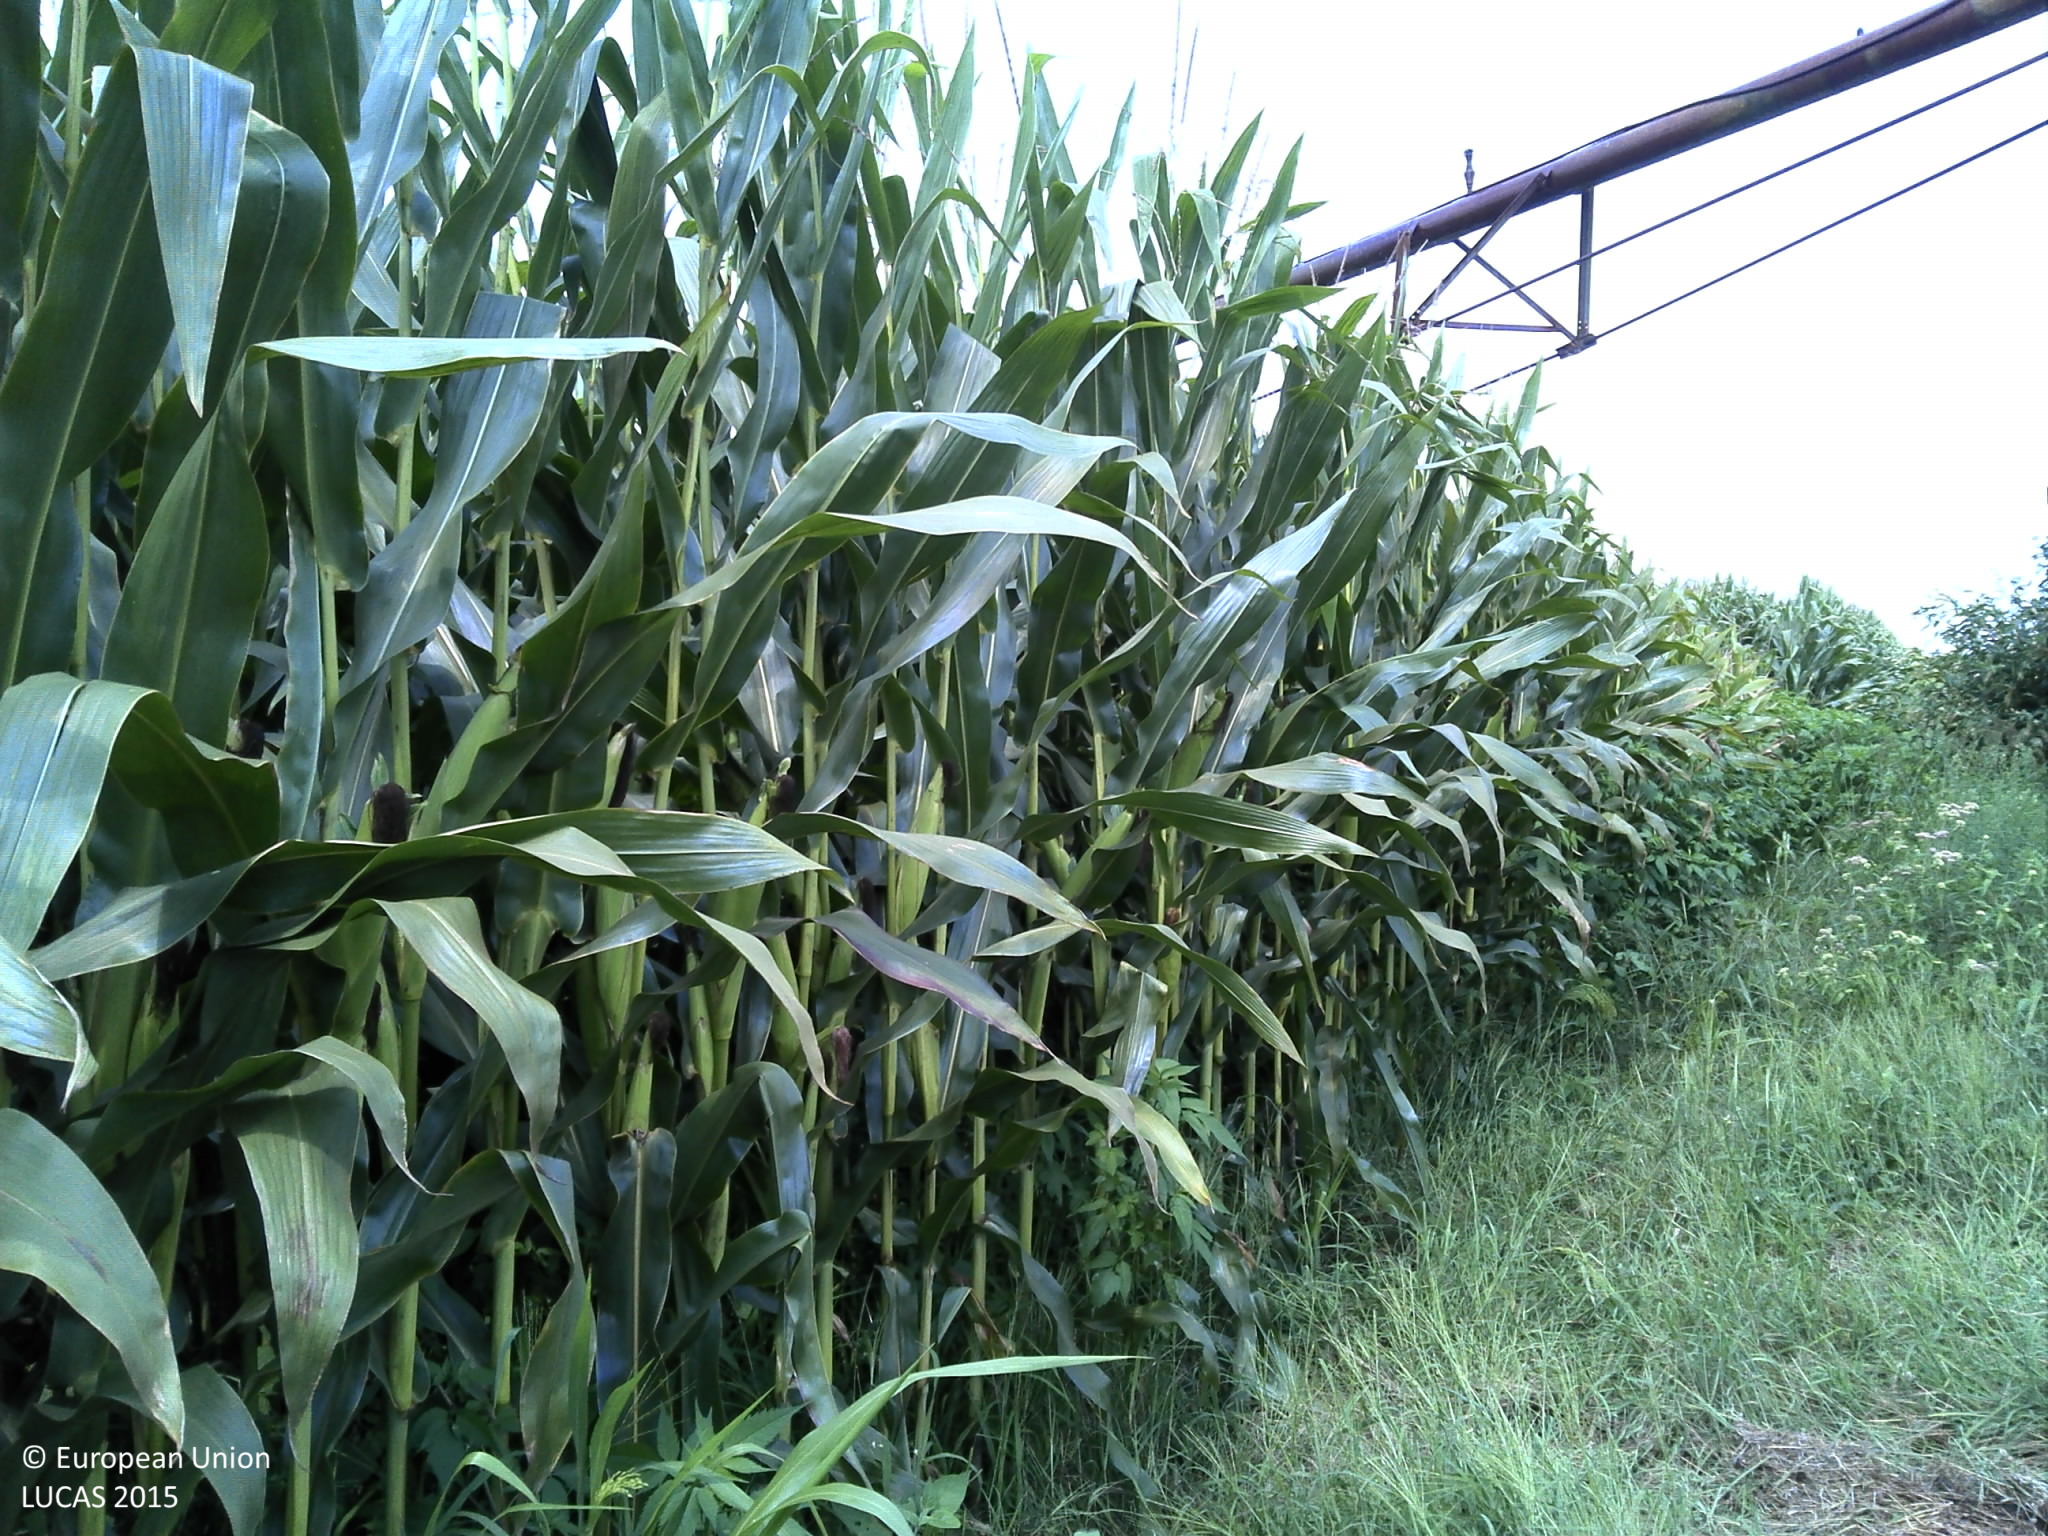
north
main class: Cropland
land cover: Maize
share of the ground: > 75 %
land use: Agriculture (excluding fallow land and kitchen gardens)
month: August
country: FR
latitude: 45.2171
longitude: -1.0146
